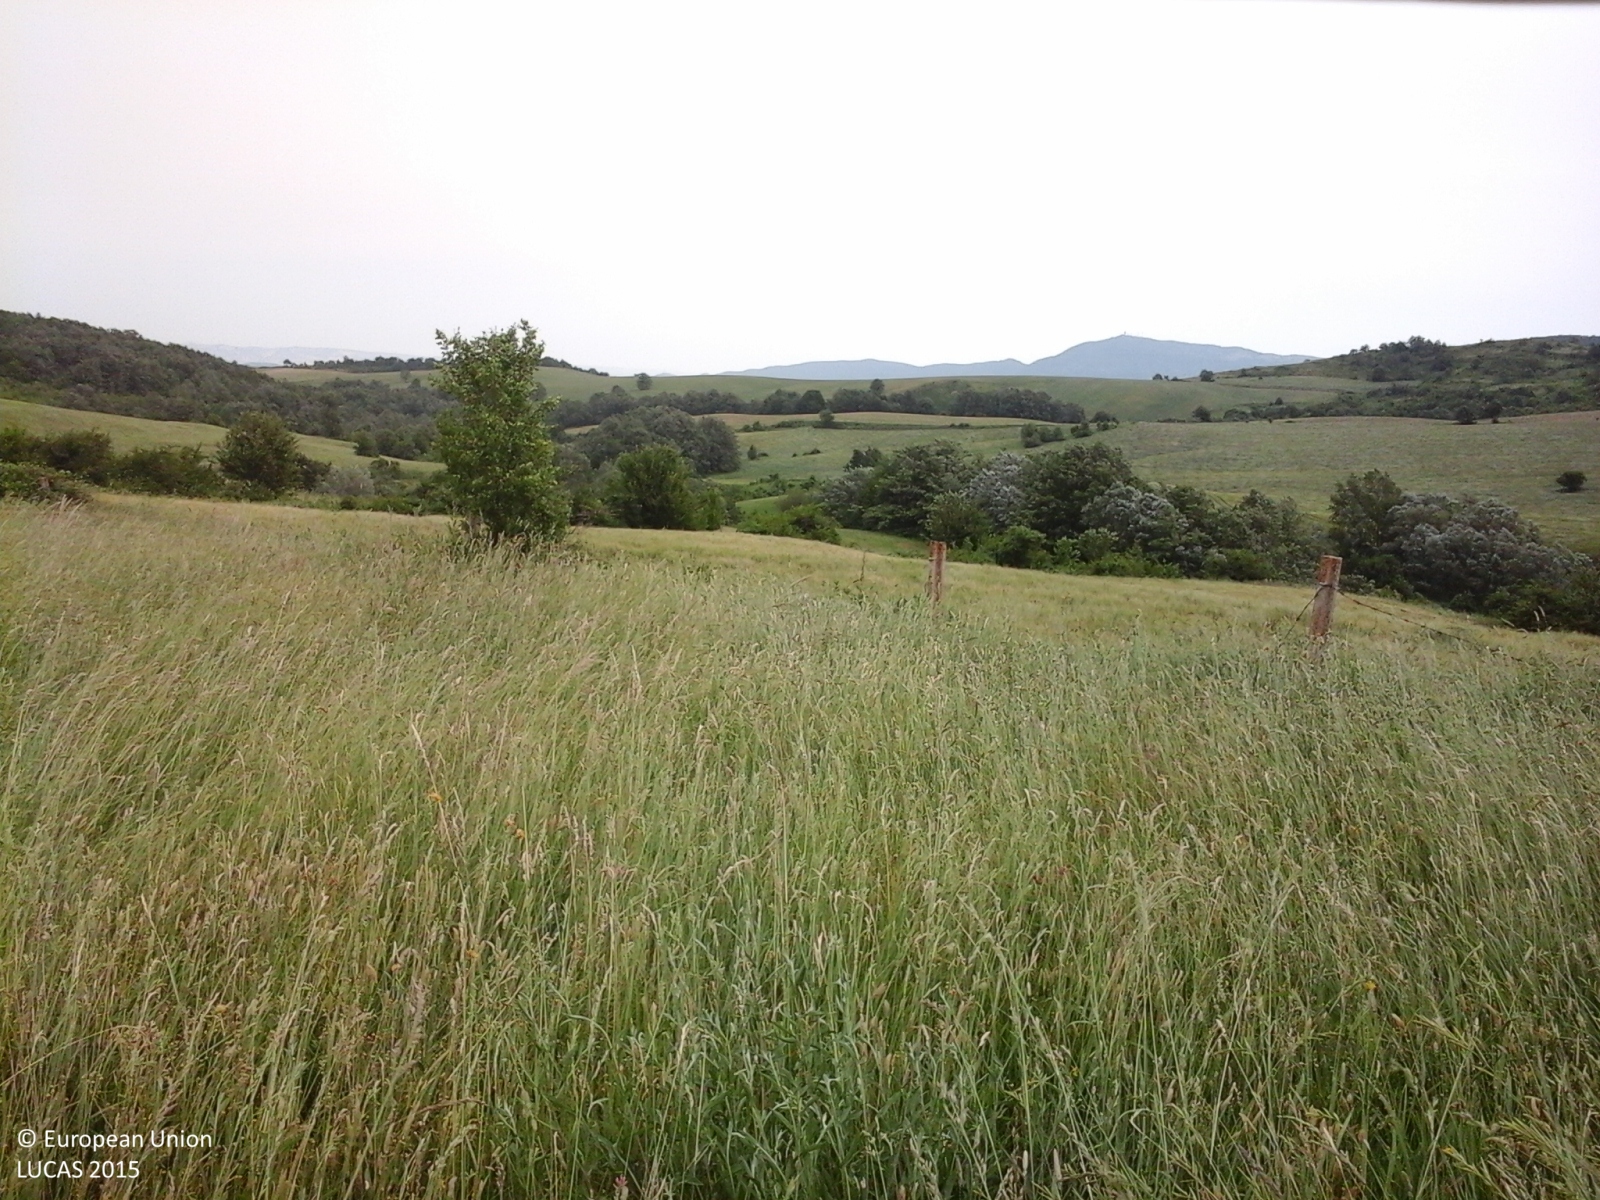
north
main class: Cropland
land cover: Other leguminous and mixtures for fodder
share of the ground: > 75 %
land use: Agriculture (excluding fallow land and kitchen gardens)
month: June
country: IT
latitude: 41.9661
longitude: 14.2936
